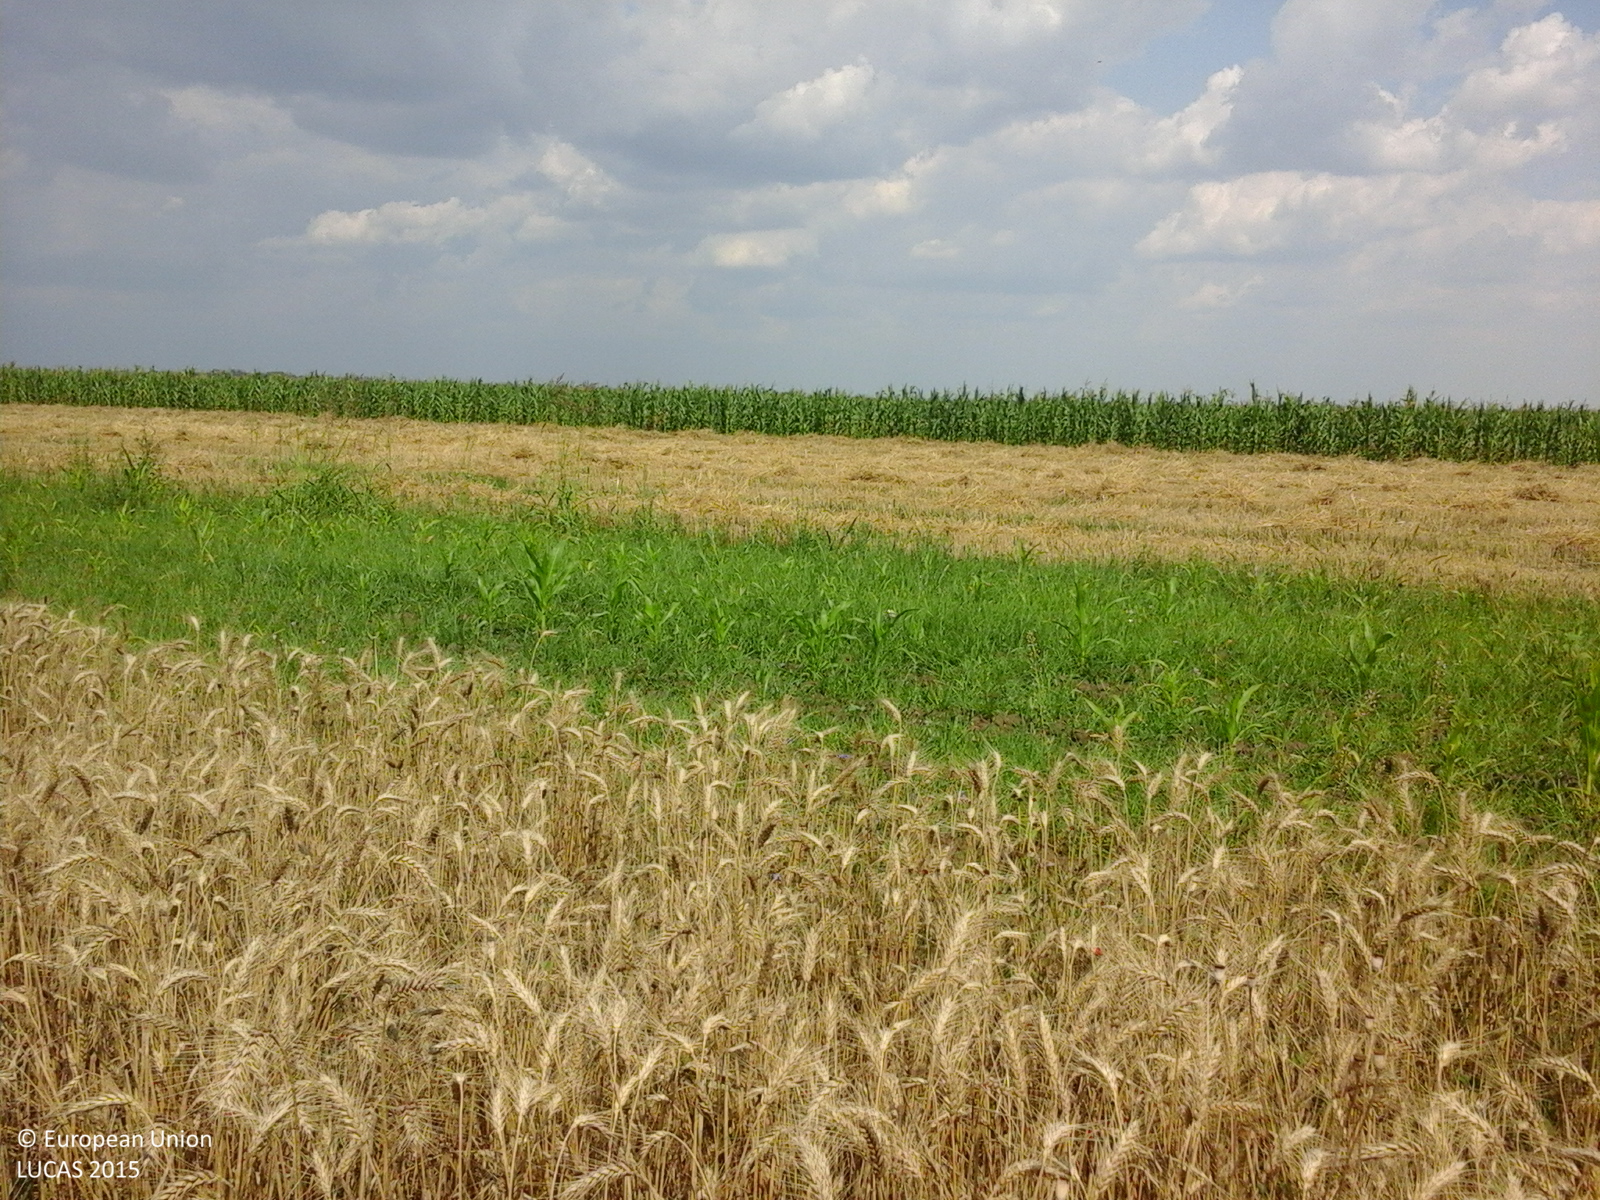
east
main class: Cropland
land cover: Common wheat
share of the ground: > 75 %
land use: Agriculture (excluding fallow land and kitchen gardens)
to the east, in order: Common wheat; Maize; Common wheat; Maize; Common wheat; Maize; Sunflower; Maize; Sunflower; Grassland without tree/shrub cover; Maize; Common wheat; Maize; Common wheat
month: July
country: RO
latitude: 44.0132
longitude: 25.1858
